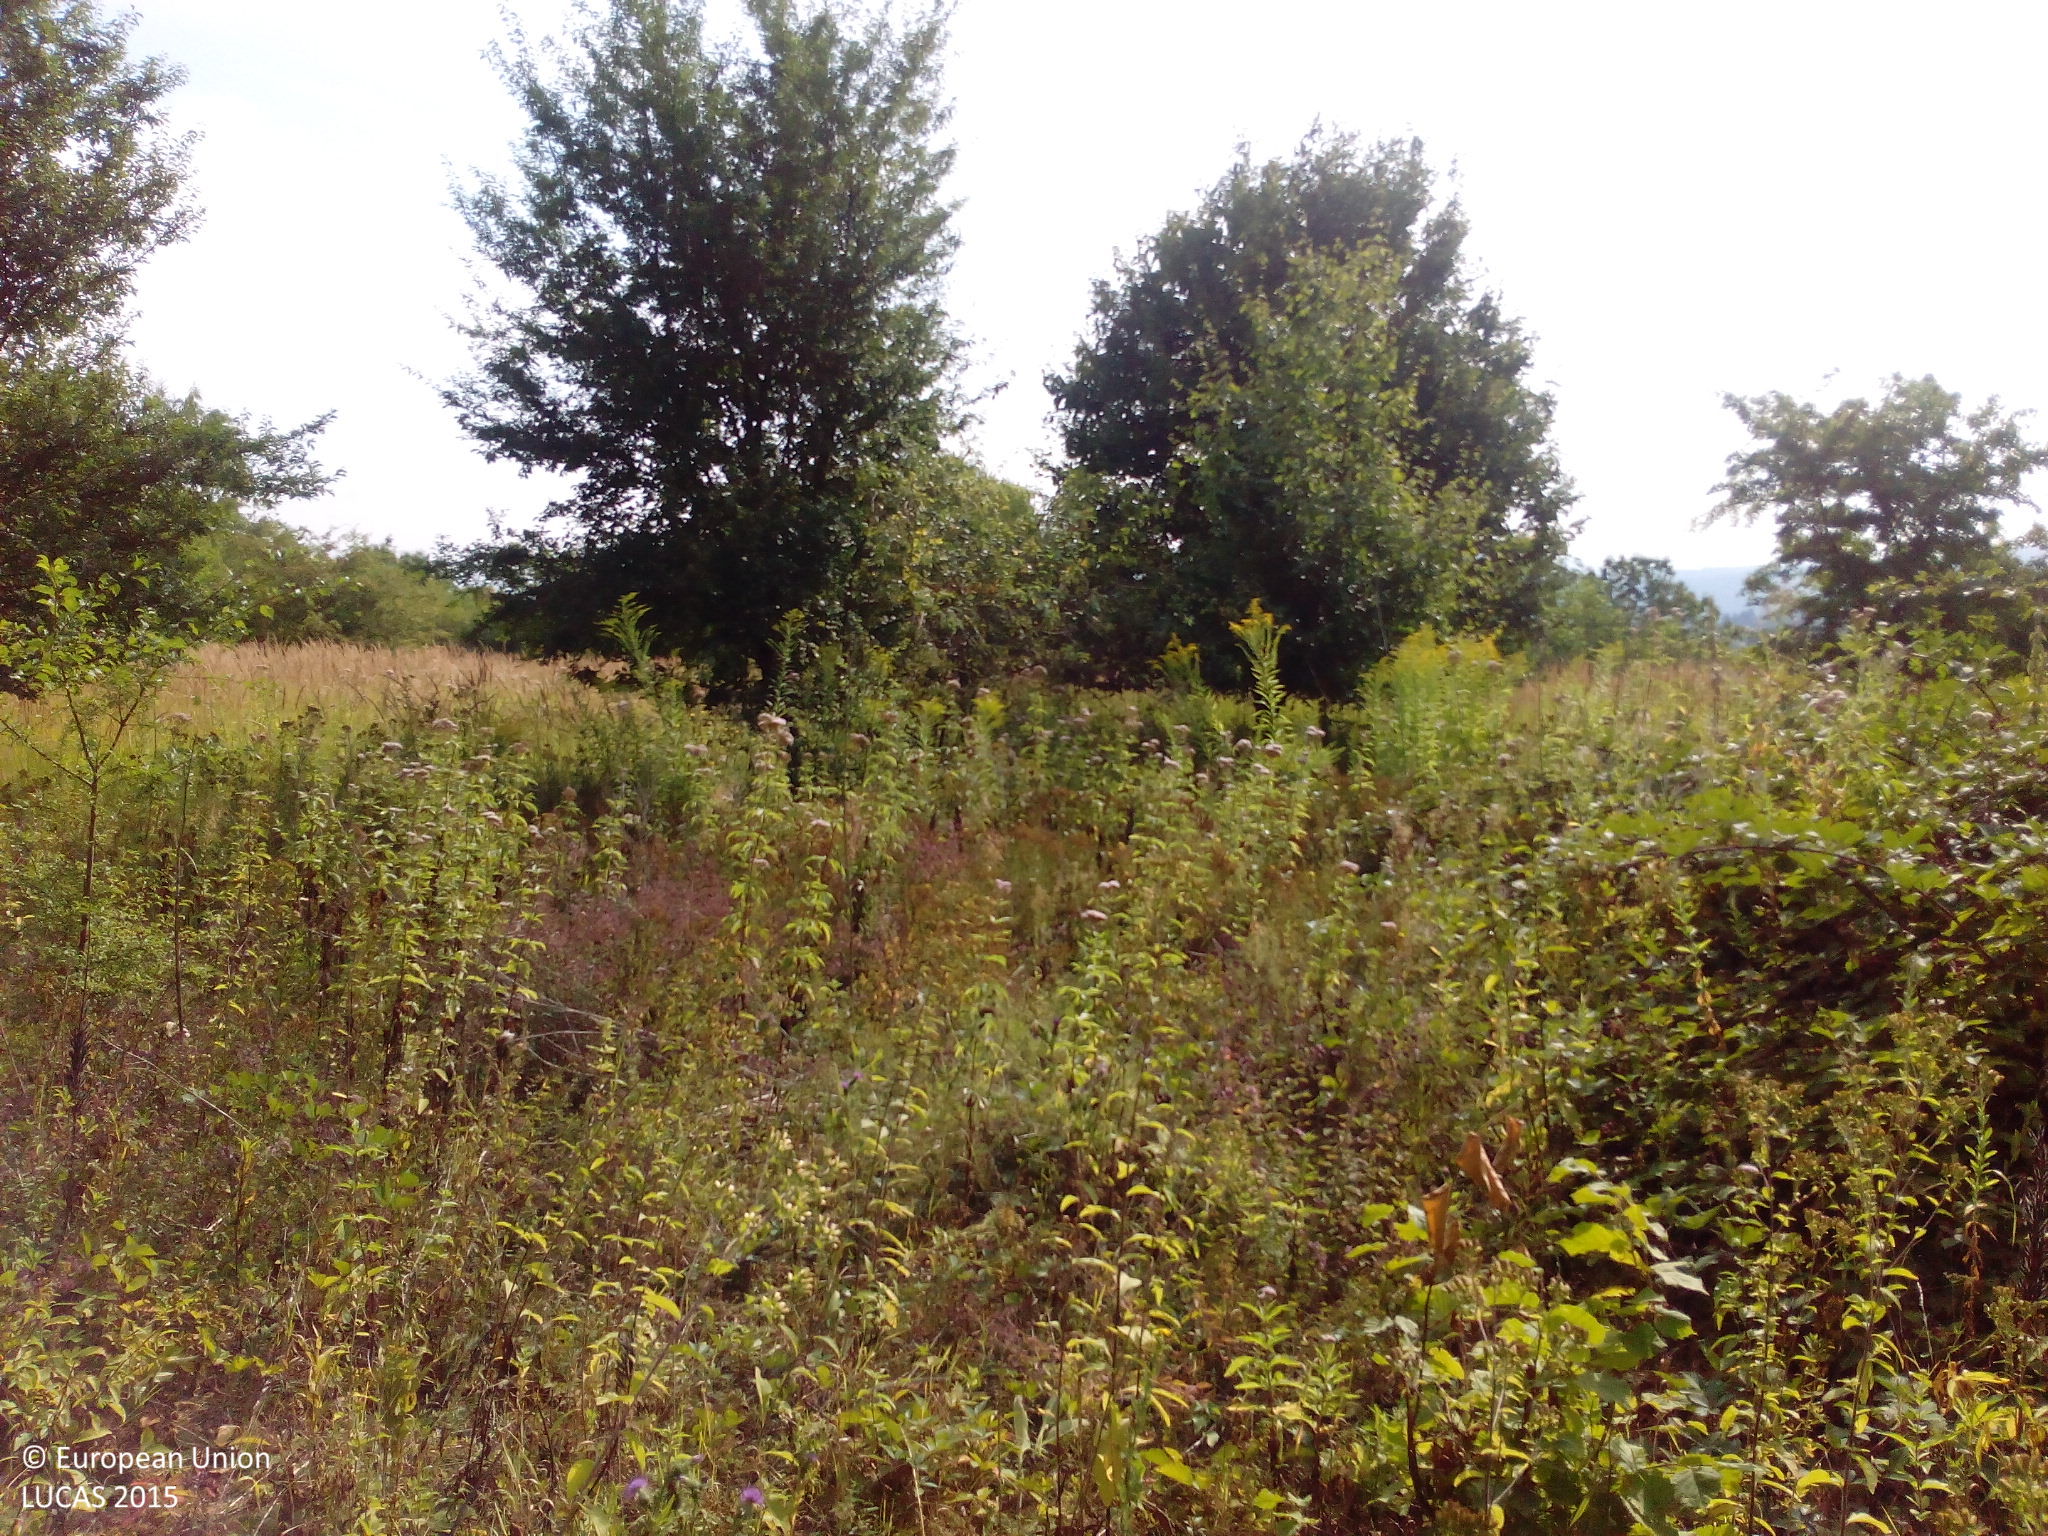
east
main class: Woodland
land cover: Broadleaved woodland
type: acidophilous oak and oak-birch forest
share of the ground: 25 - 50 %
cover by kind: herbaceous plants 50 %, broadleaved forest trees 40 %, shrubs 10 %
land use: Semi-natural and natural areas not in use
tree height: > 5 m
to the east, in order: Broadleaved woodland; Grassland with sparse tree/shrub cover; Grassland without tree/shrub cover; Broadleaved woodland; Spontaneously vegetated surfaces; Tracks; Other fruit trees and berries; Grassland without tree/shrub cover; Sugar beet; Grass margins; Abandoned hedges; Paved roads, cycling and walking lanes; Lines of trees; Ditches and canals; Grass margins; Paved roads, cycling and walking lanes; Lines of trees; Grass margins; Paved roads, cycling and walking lanes; Cherry fruit
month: August
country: DE
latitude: 50.3370
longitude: 7.5134
